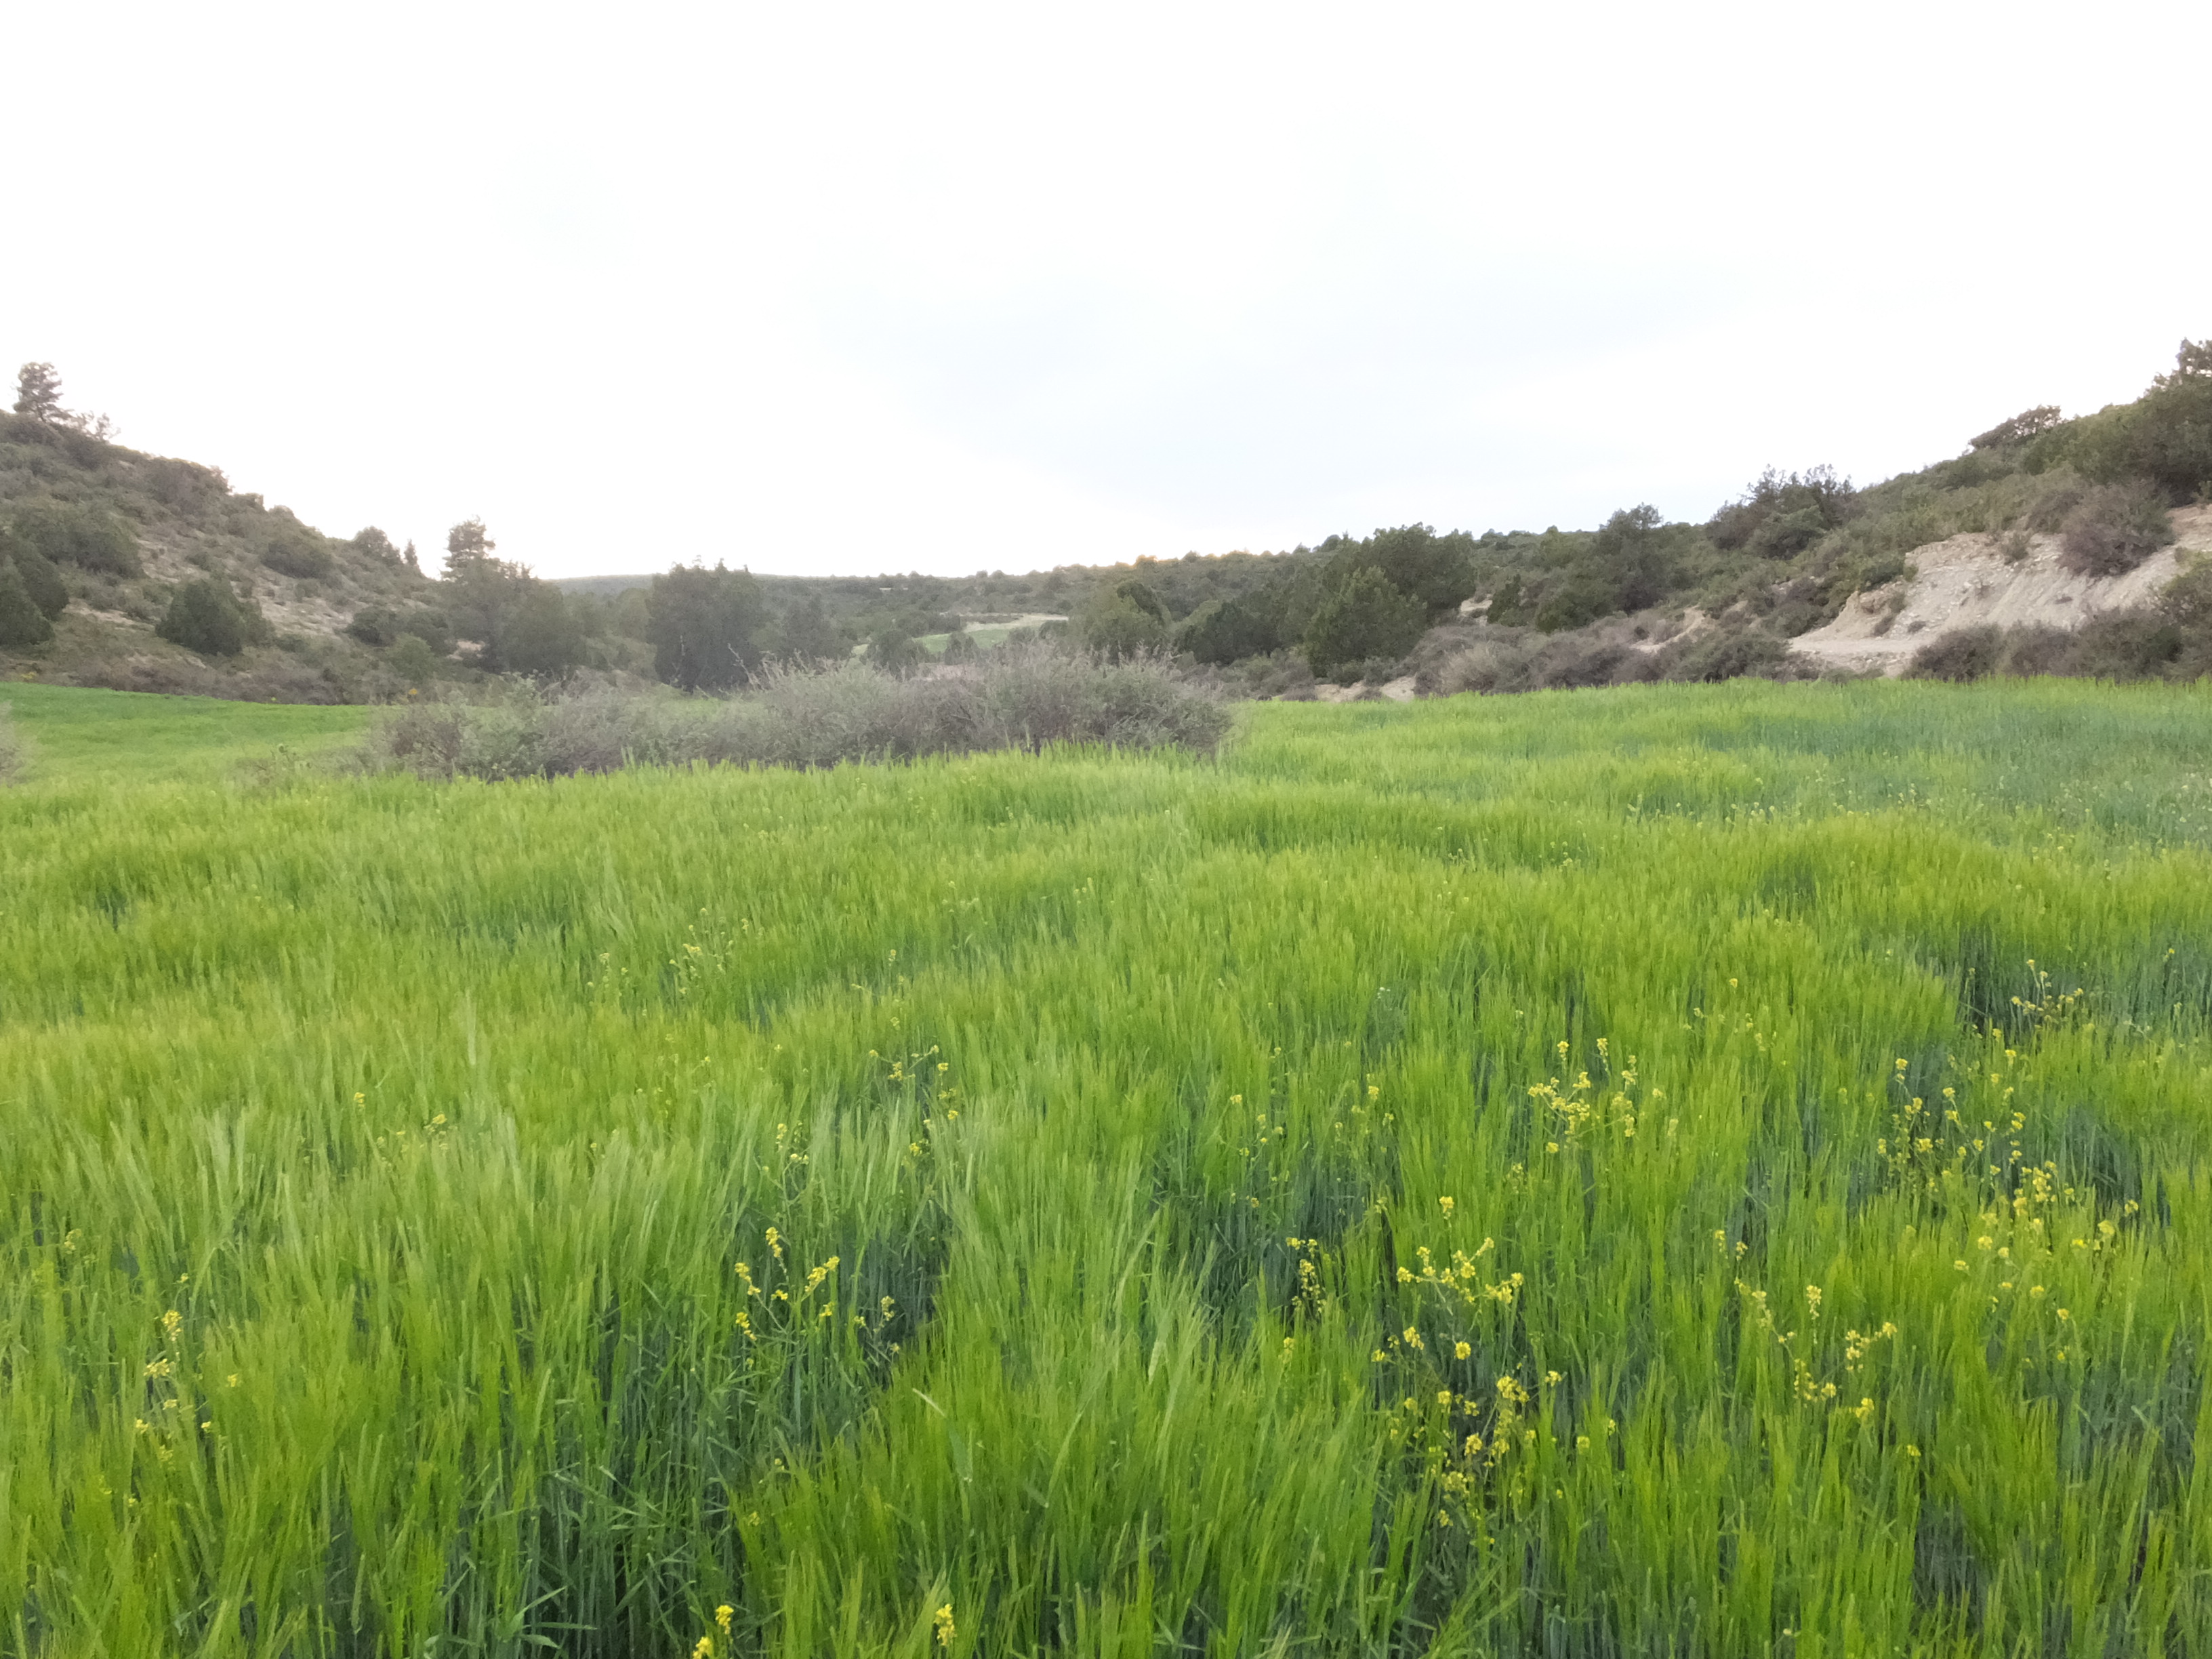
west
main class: Cropland
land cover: Barley
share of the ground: > 75 %
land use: Agriculture (excluding fallow land and kitchen gardens)
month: April
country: ES
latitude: 41.6585
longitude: -0.2610
